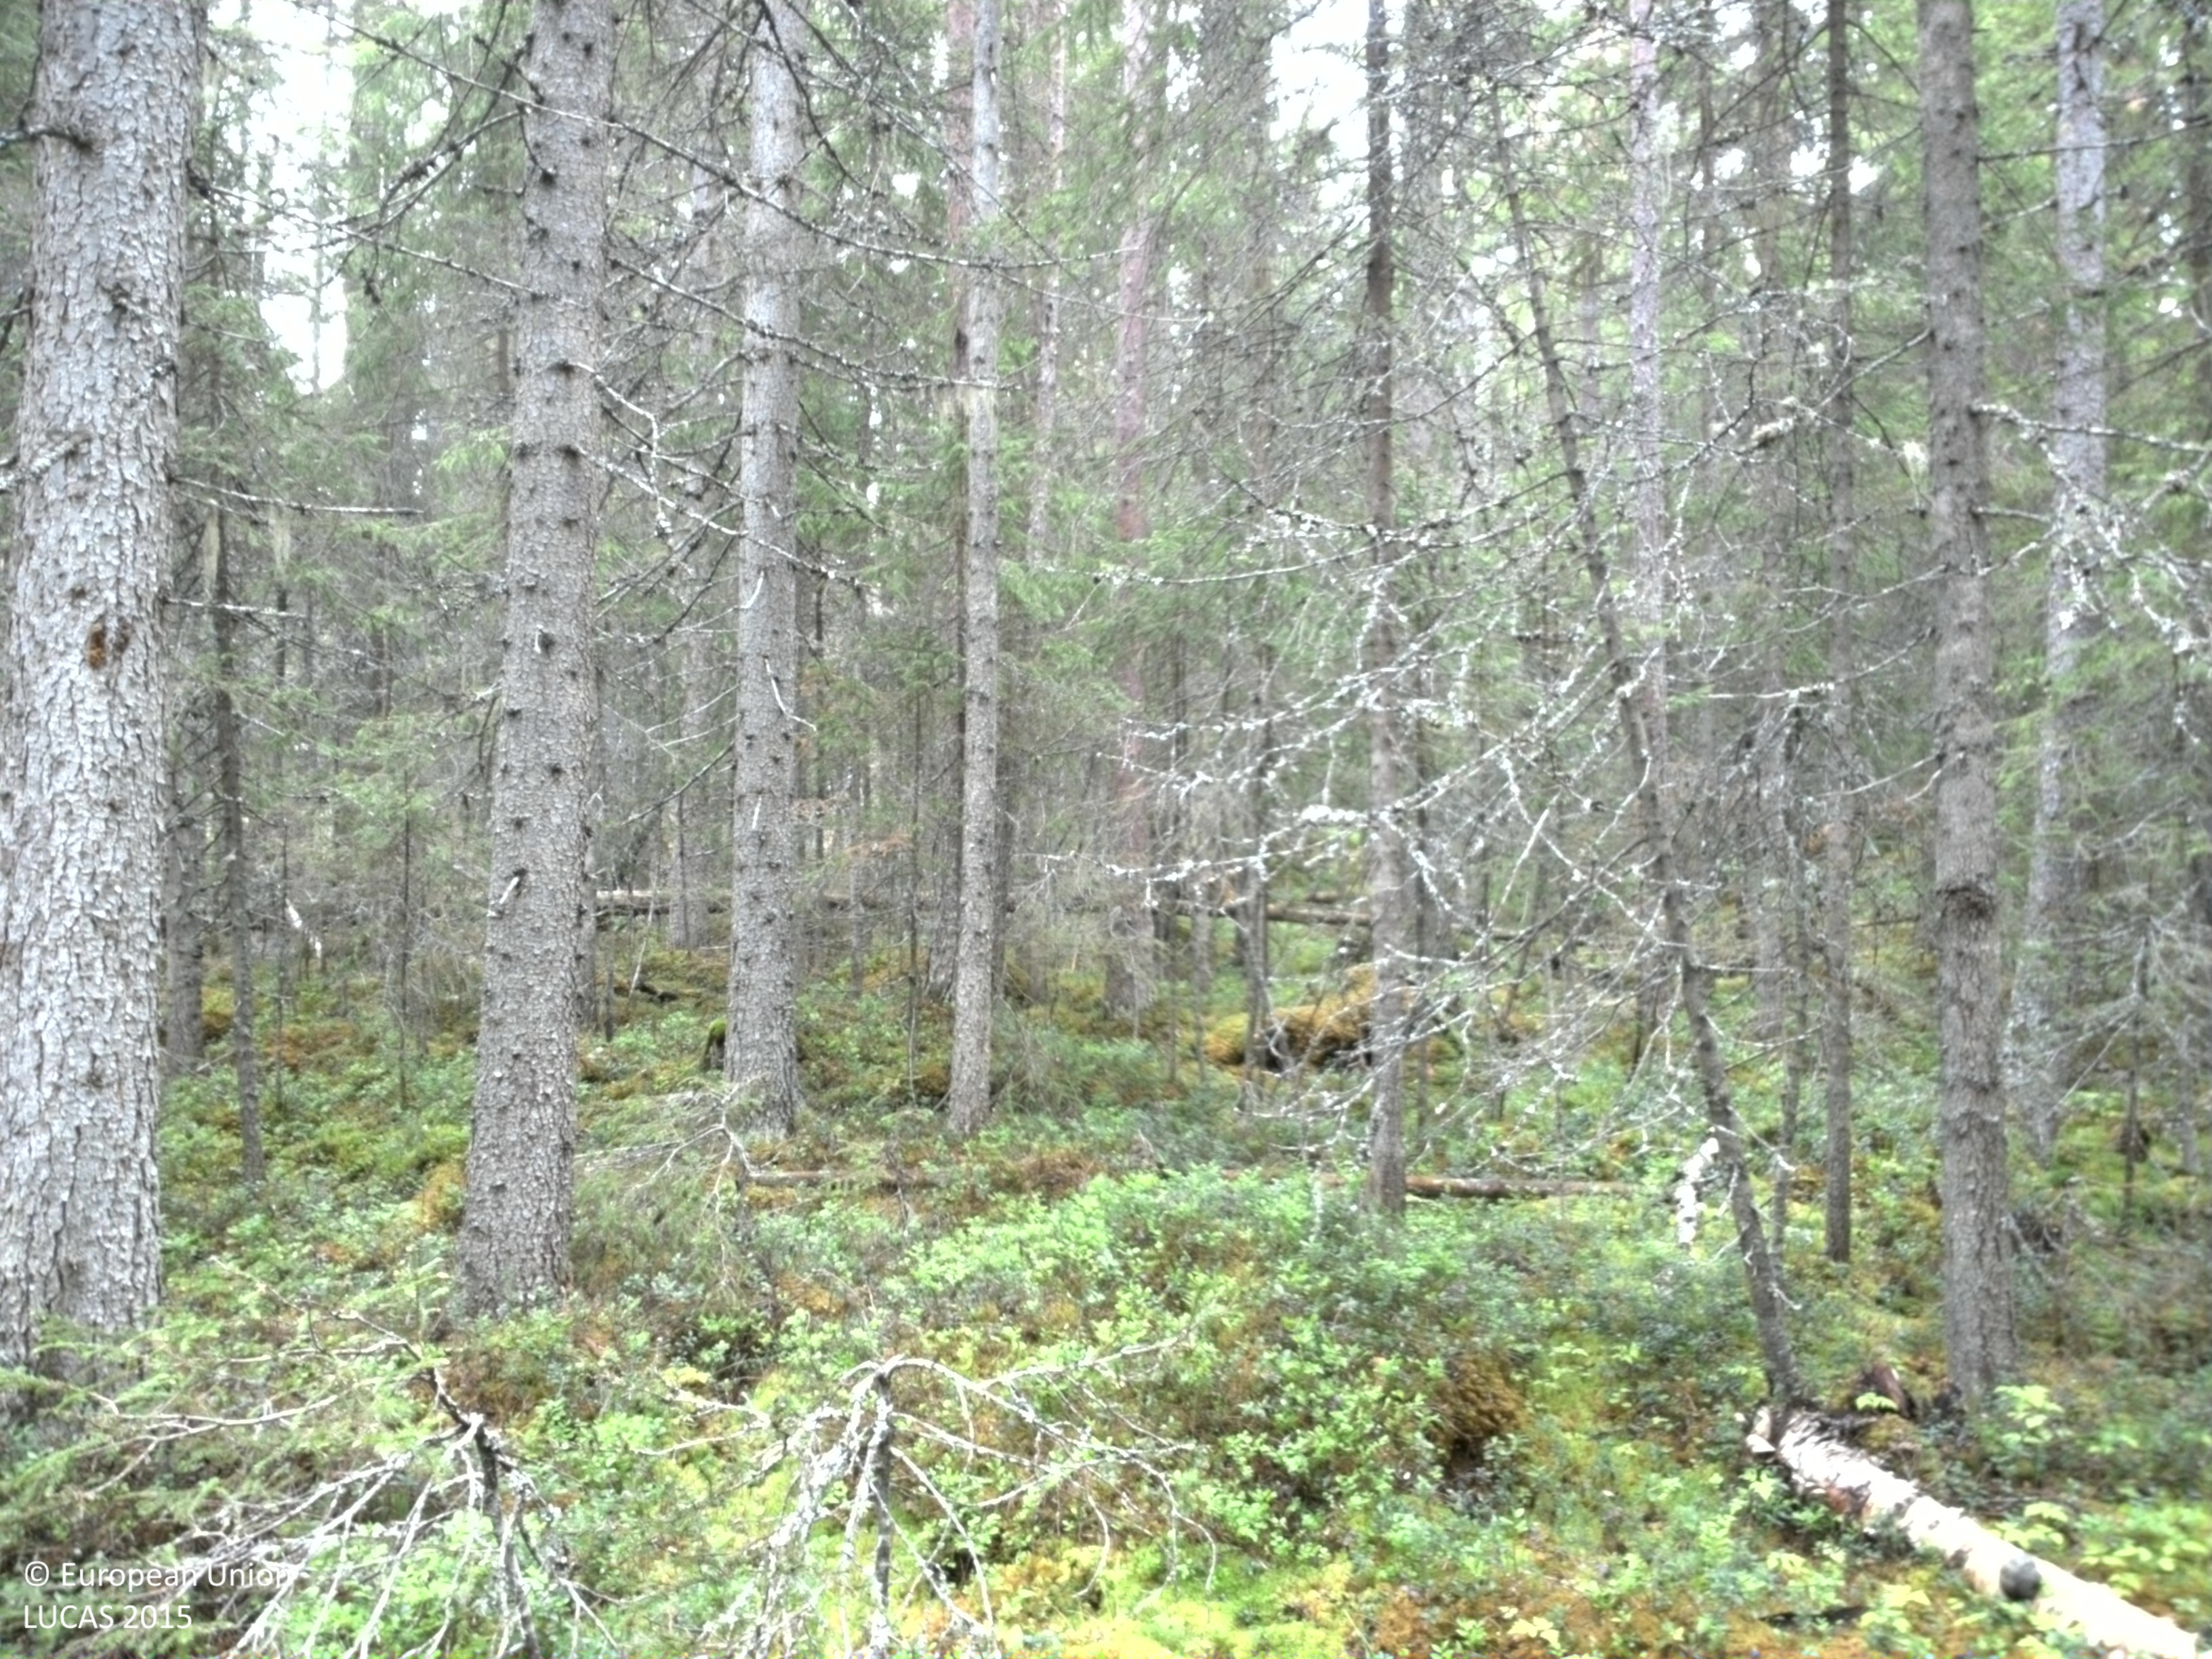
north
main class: Woodland
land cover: Spruce dominated coniferous woodland
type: boreal forest
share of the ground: > 75 %
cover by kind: coniferous forest trees 80 %, shrubs 10 %, lichens and mosses 10 %
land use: Forestry
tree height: > 5 m
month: June
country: SE
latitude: 62.2259
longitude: 13.6206
